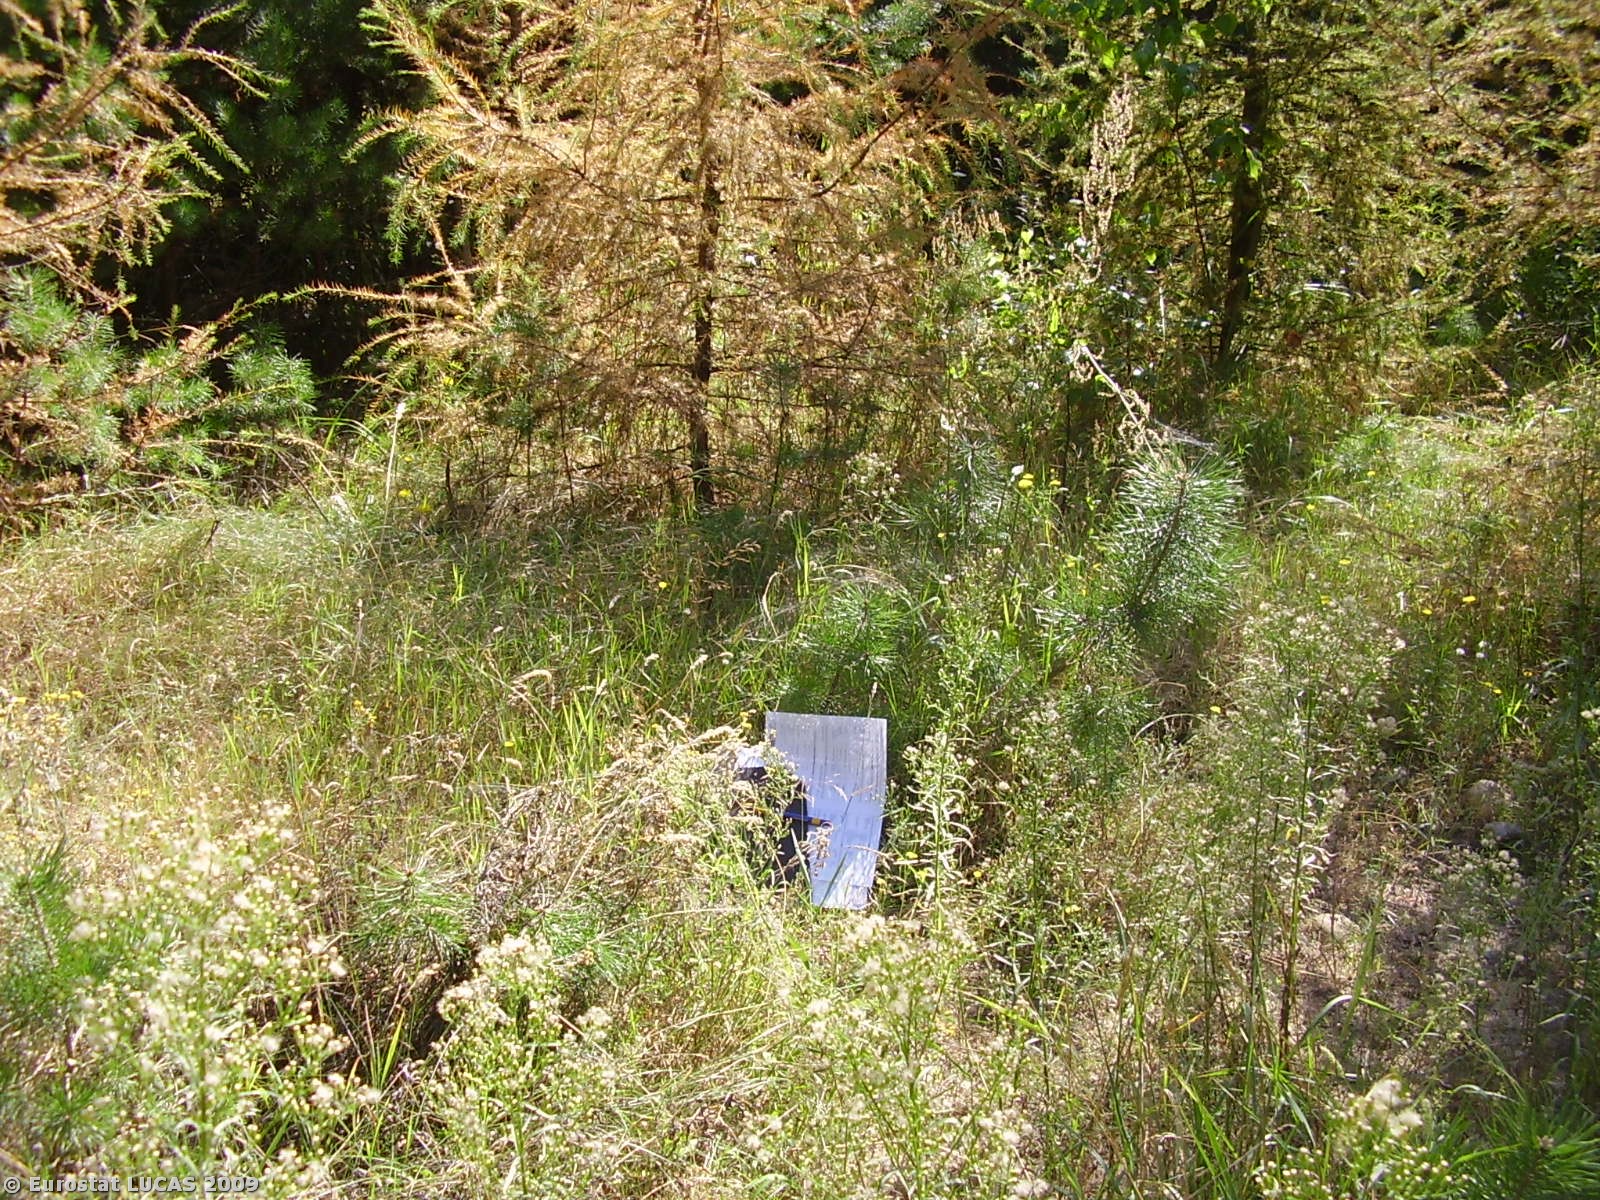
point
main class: Woodland
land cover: Coniferous woodland
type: hemiboreal forest and nemoral coniferous forest and mixed broadleaved-coniferous forest
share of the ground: > 75 %
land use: Forestry
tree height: > 5 m
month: August
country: PL
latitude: 51.3346
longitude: 16.7983
